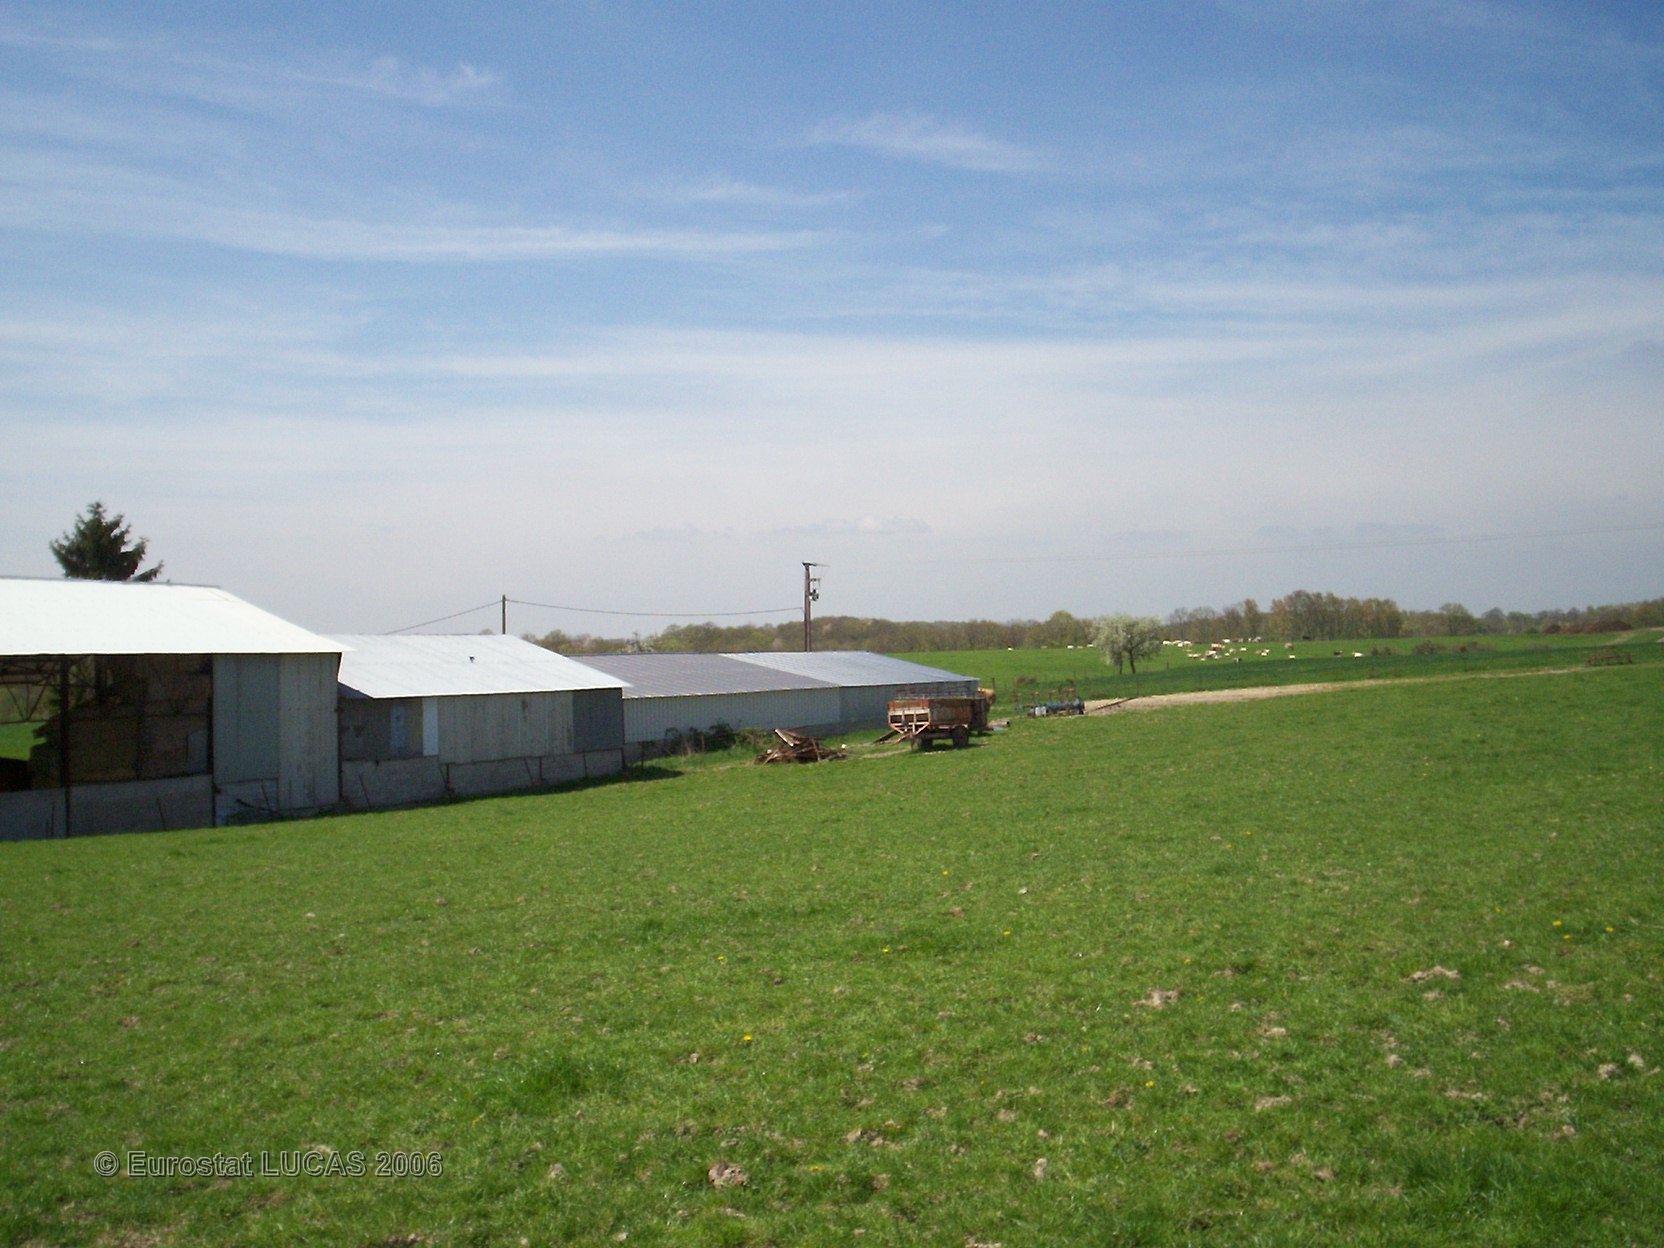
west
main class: Grassland
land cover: Grassland without tree/shrub cover
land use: Agriculture (excluding fallow land and kitchen gardens)
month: April
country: FR
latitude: 49.6825
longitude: 4.3270
